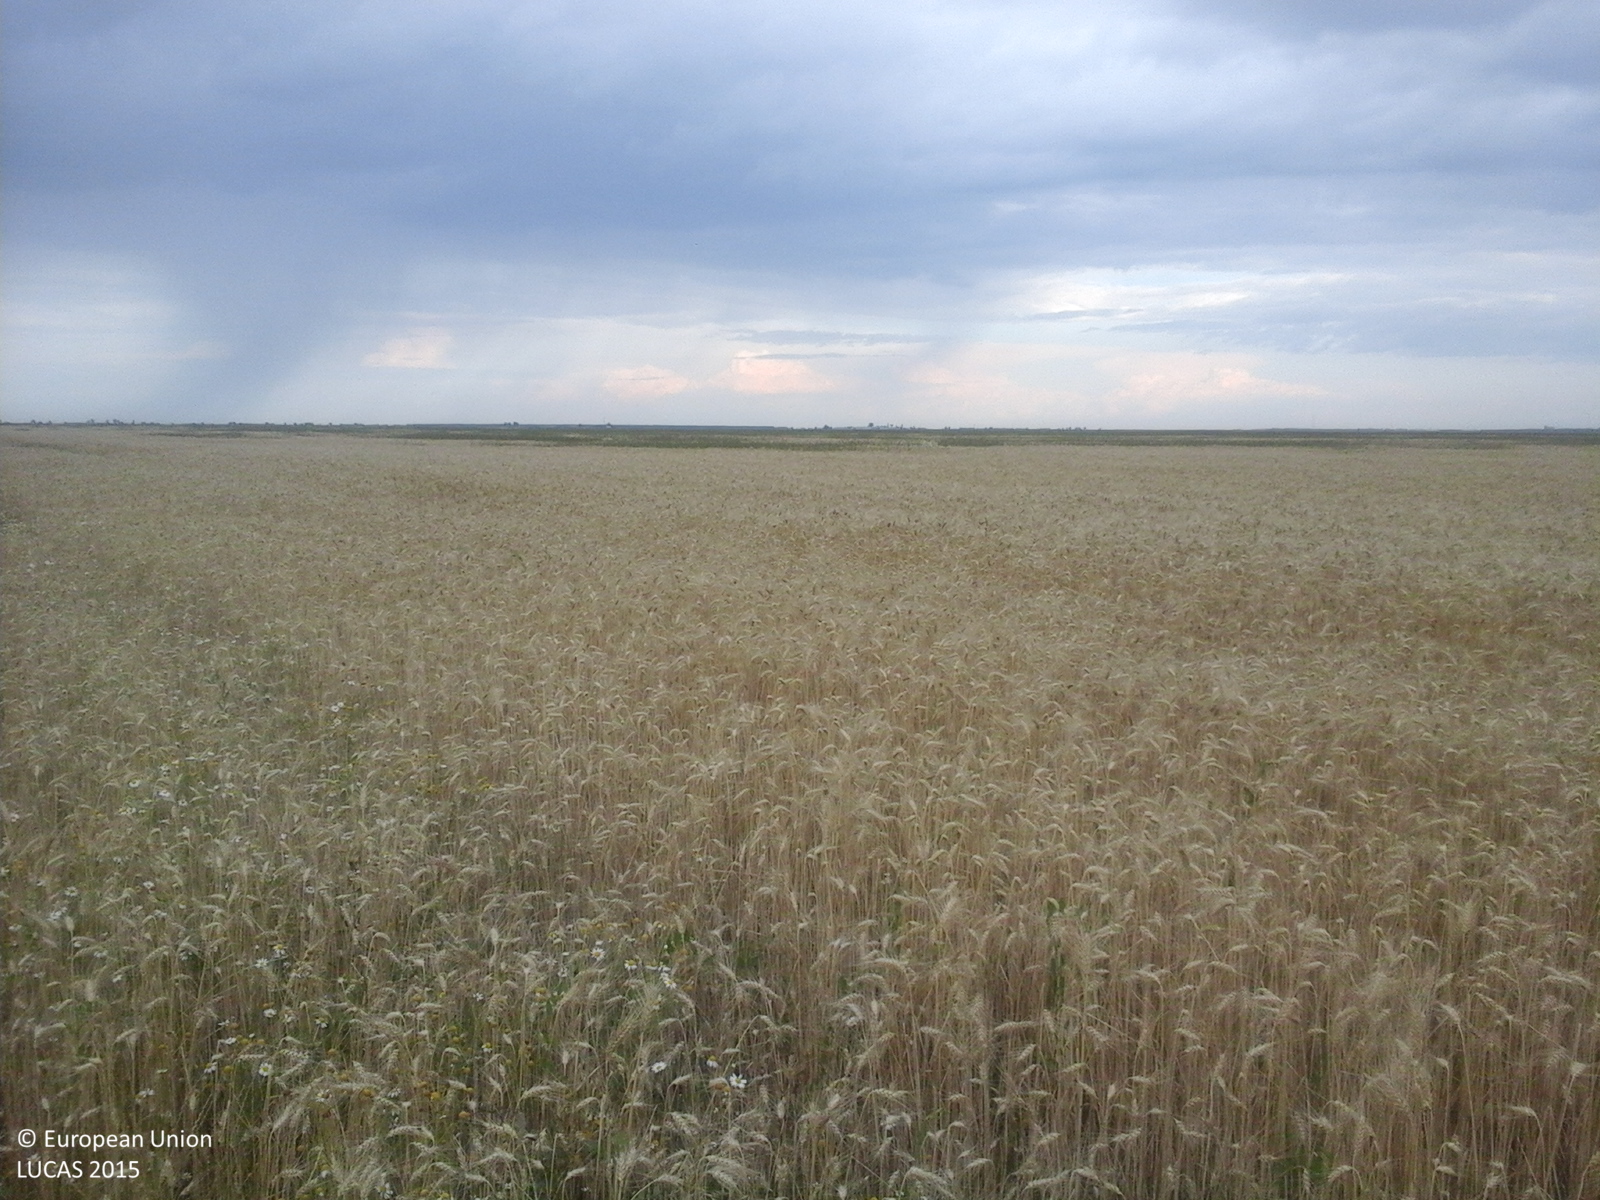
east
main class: Cropland
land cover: Common wheat
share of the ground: > 75 %
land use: Agriculture (excluding fallow land and kitchen gardens)
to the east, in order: Common wheat
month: July
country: RO
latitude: 44.4234
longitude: 24.8869
